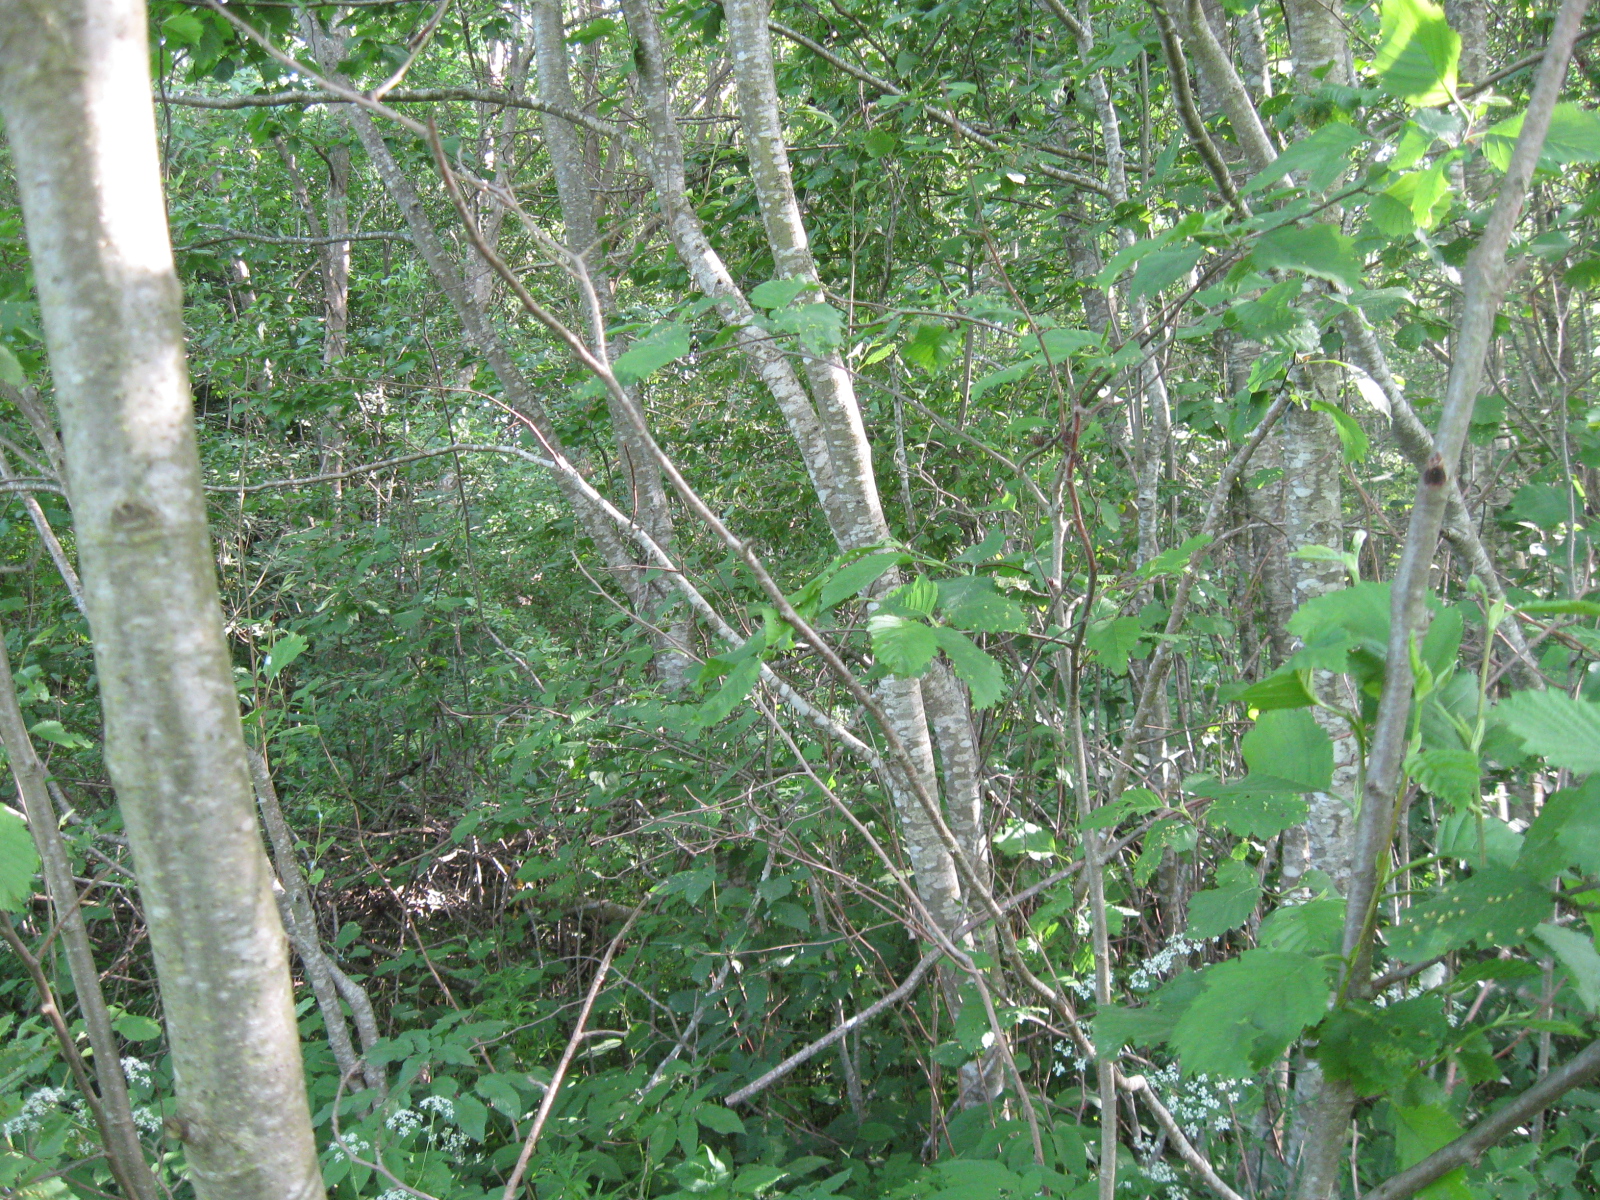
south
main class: Woodland
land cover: Broadleaved woodland
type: non-riverine alder, birch or aspen forest
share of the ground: 50 - 75 %
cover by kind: broadleaved forest trees 65 %, herbaceous plants 35 %
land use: Forestry
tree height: > 5 m
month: June
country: LT
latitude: 54.9926
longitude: 24.0176
